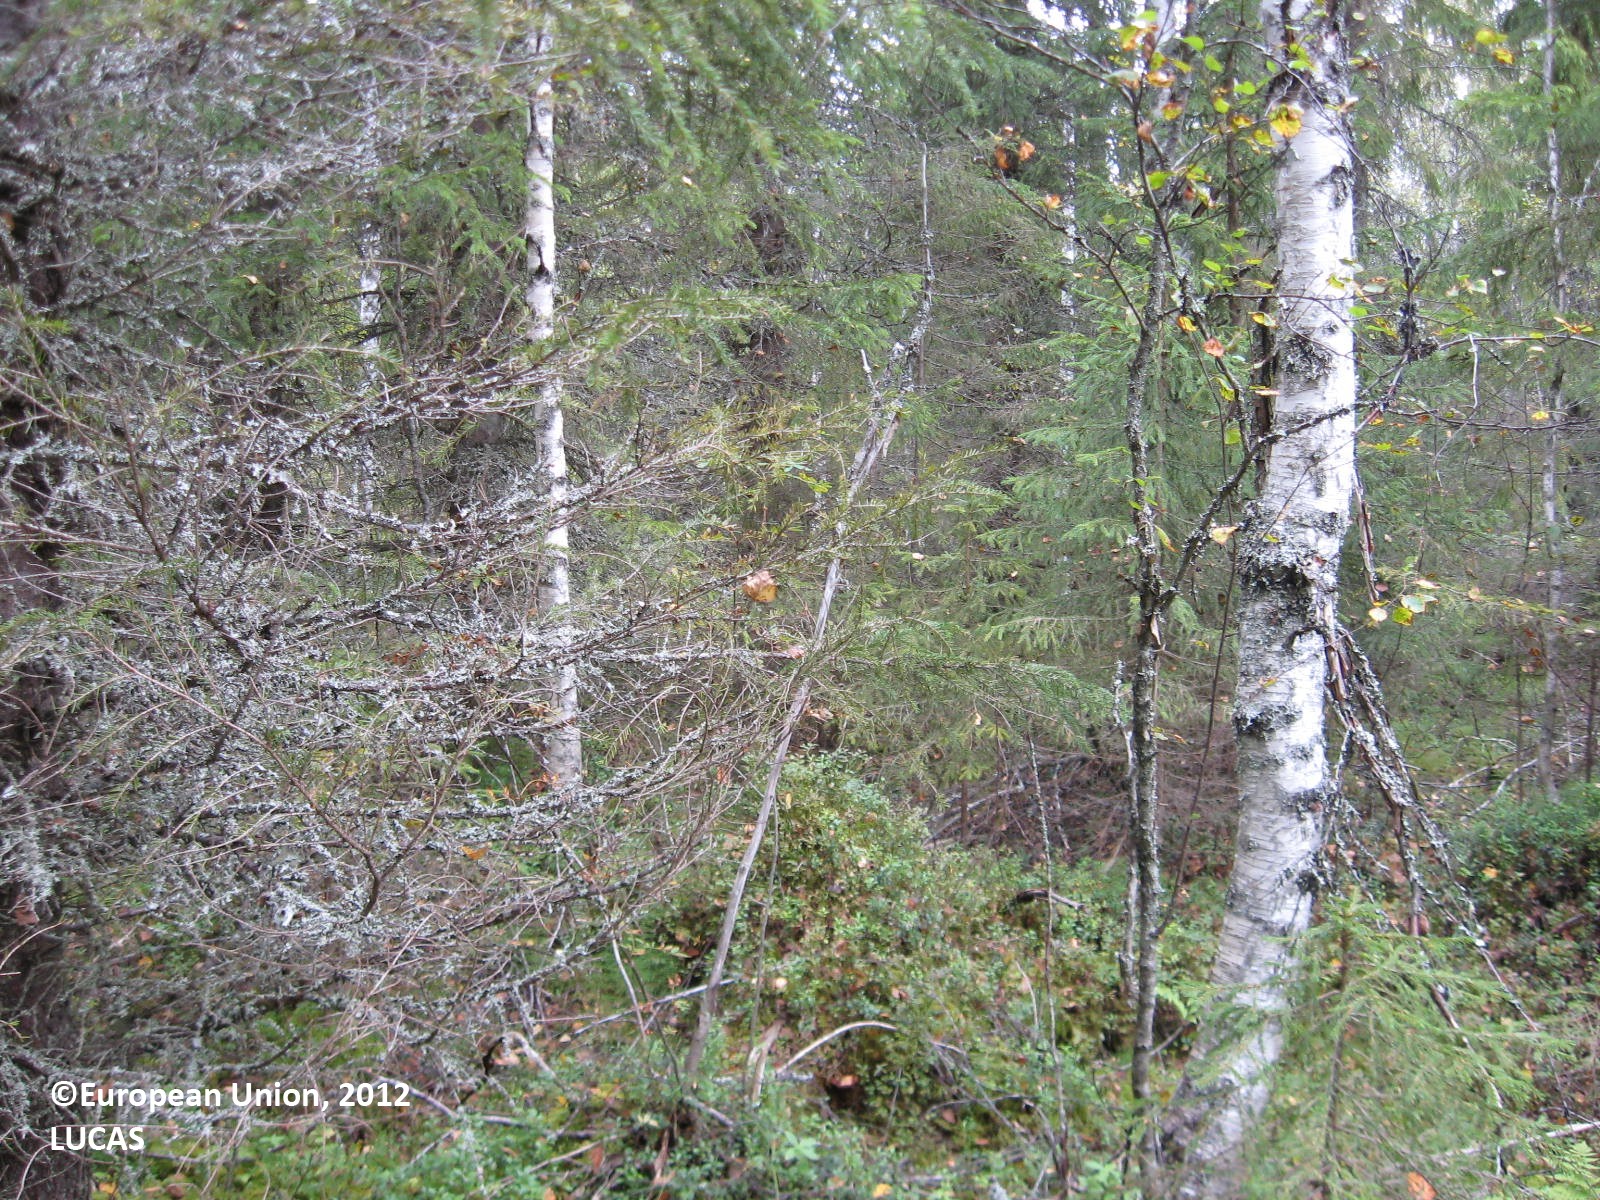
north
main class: Woodland
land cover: Other mixed woodland
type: boreal forest
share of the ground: 50 - 75 %
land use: Forestry
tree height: > 5 m
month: August
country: FI
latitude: 63.7686
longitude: 29.0445
